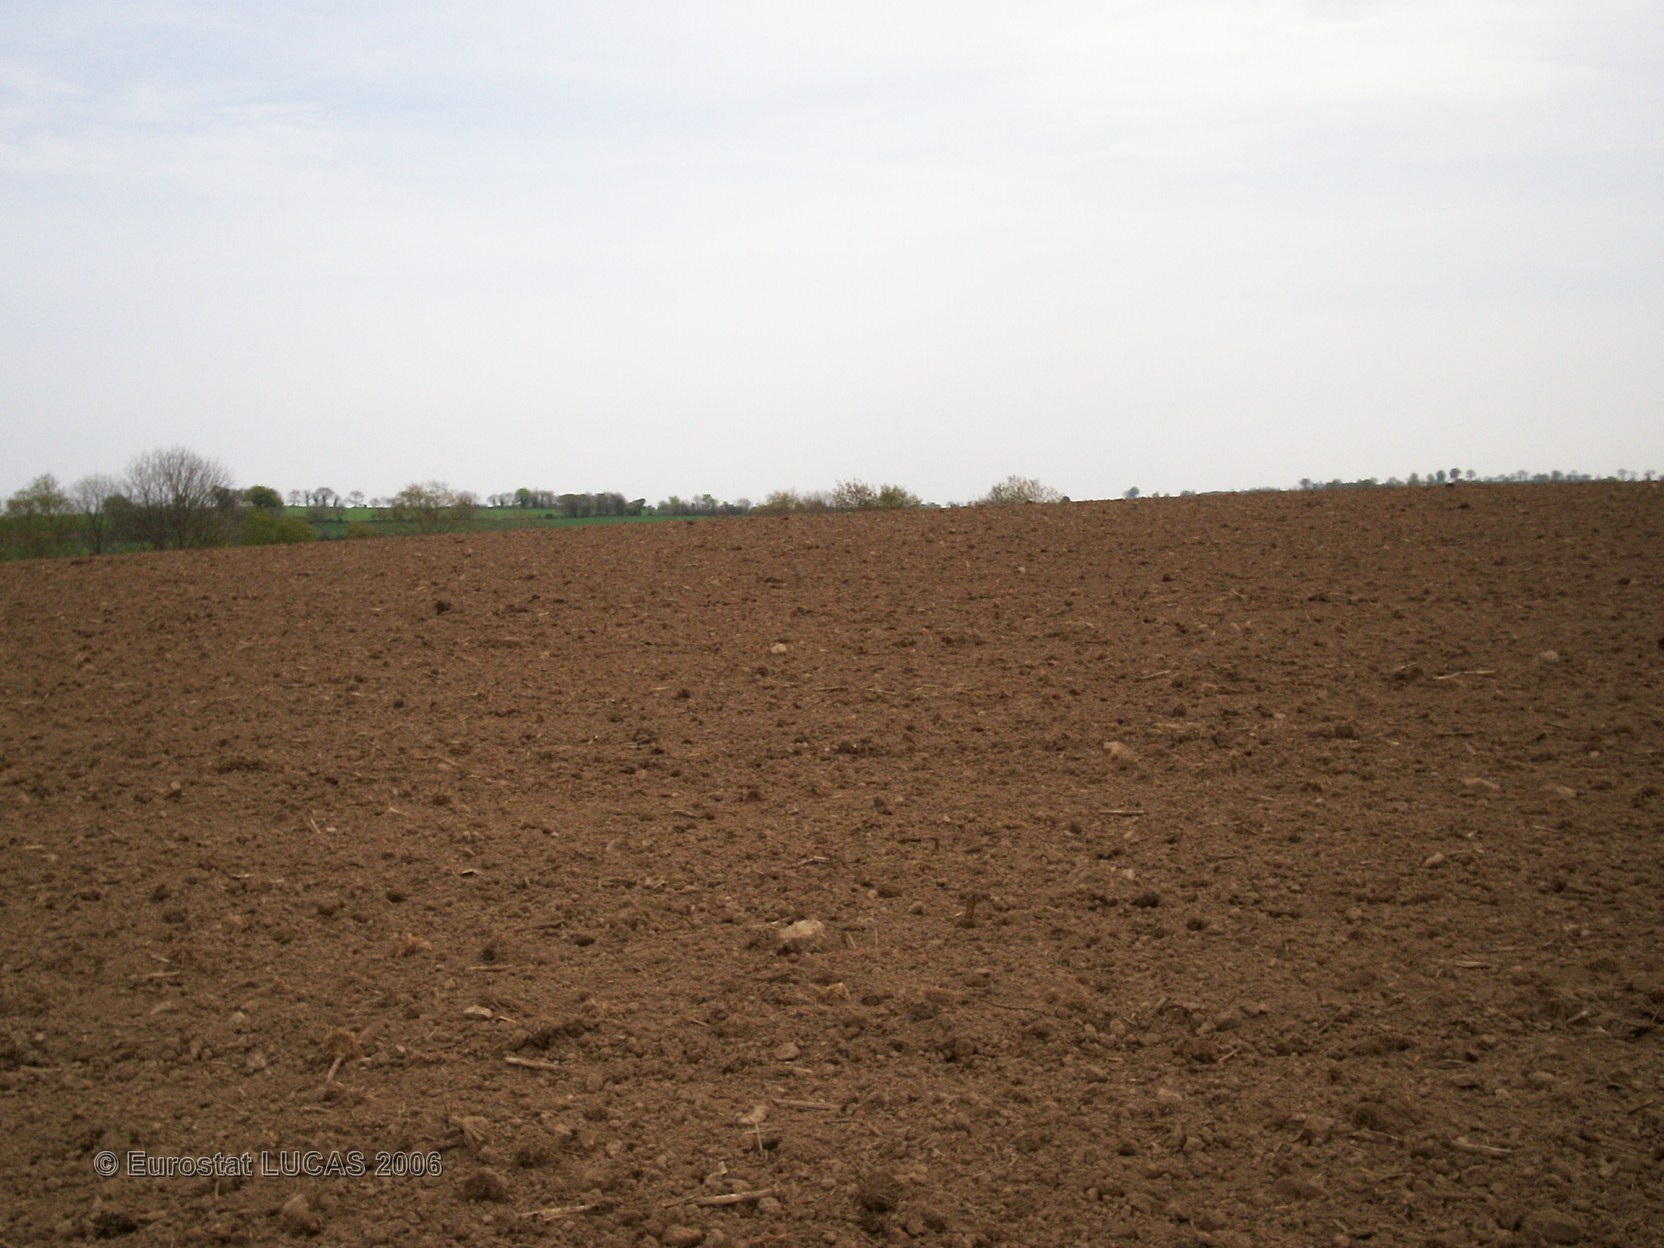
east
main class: Cropland
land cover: Maize
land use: Agriculture (excluding fallow land and kitchen gardens)
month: May
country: FR
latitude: 48.2273
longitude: -3.9383
